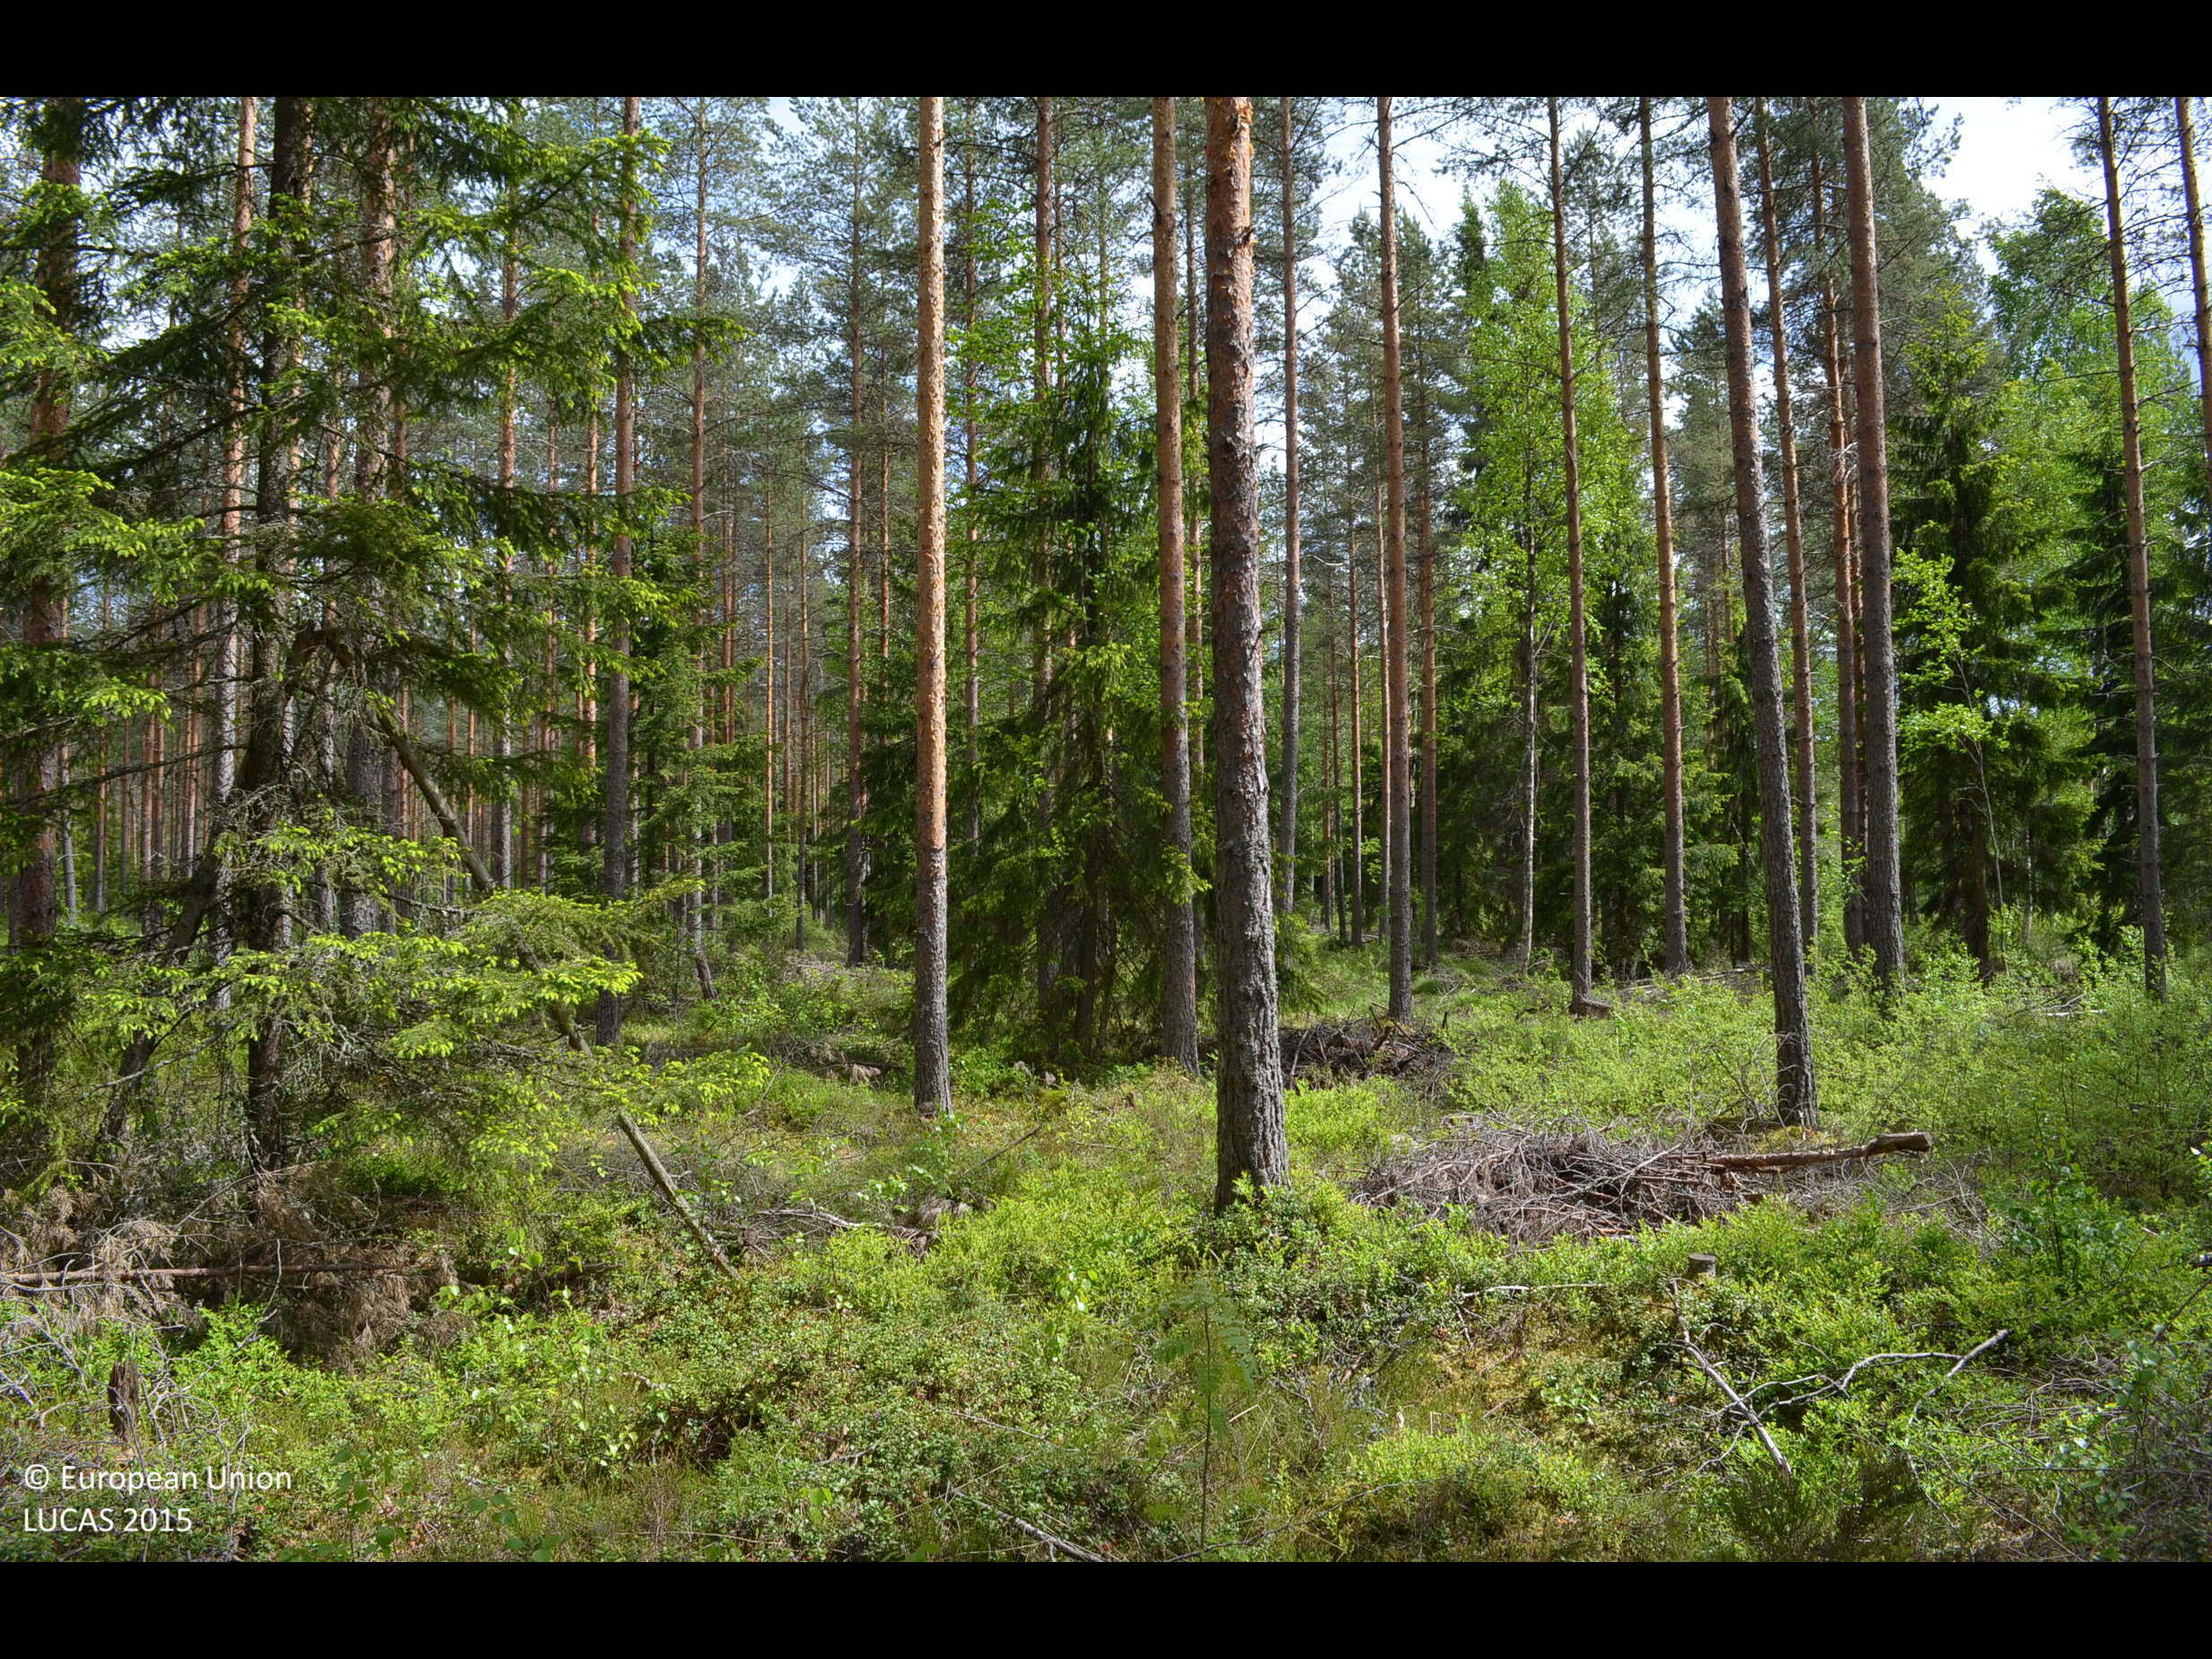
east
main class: Woodland
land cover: Pine dominated coniferous woodland
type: boreal forest
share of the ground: 50 - 75 %
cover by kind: coniferous forest trees 65 %, shrubs 25 %, broadleaved forest trees 5 %
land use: Forestry
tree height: > 5 m
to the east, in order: Pine dominated coniferous woodland; Ditches and canals; Pine dominated coniferous woodland; Ditches and canals; Pine dominated mixed woodland; Ditches and canals; Pine dominated mixed woodland
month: June
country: FI
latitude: 61.9927
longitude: 23.1844
